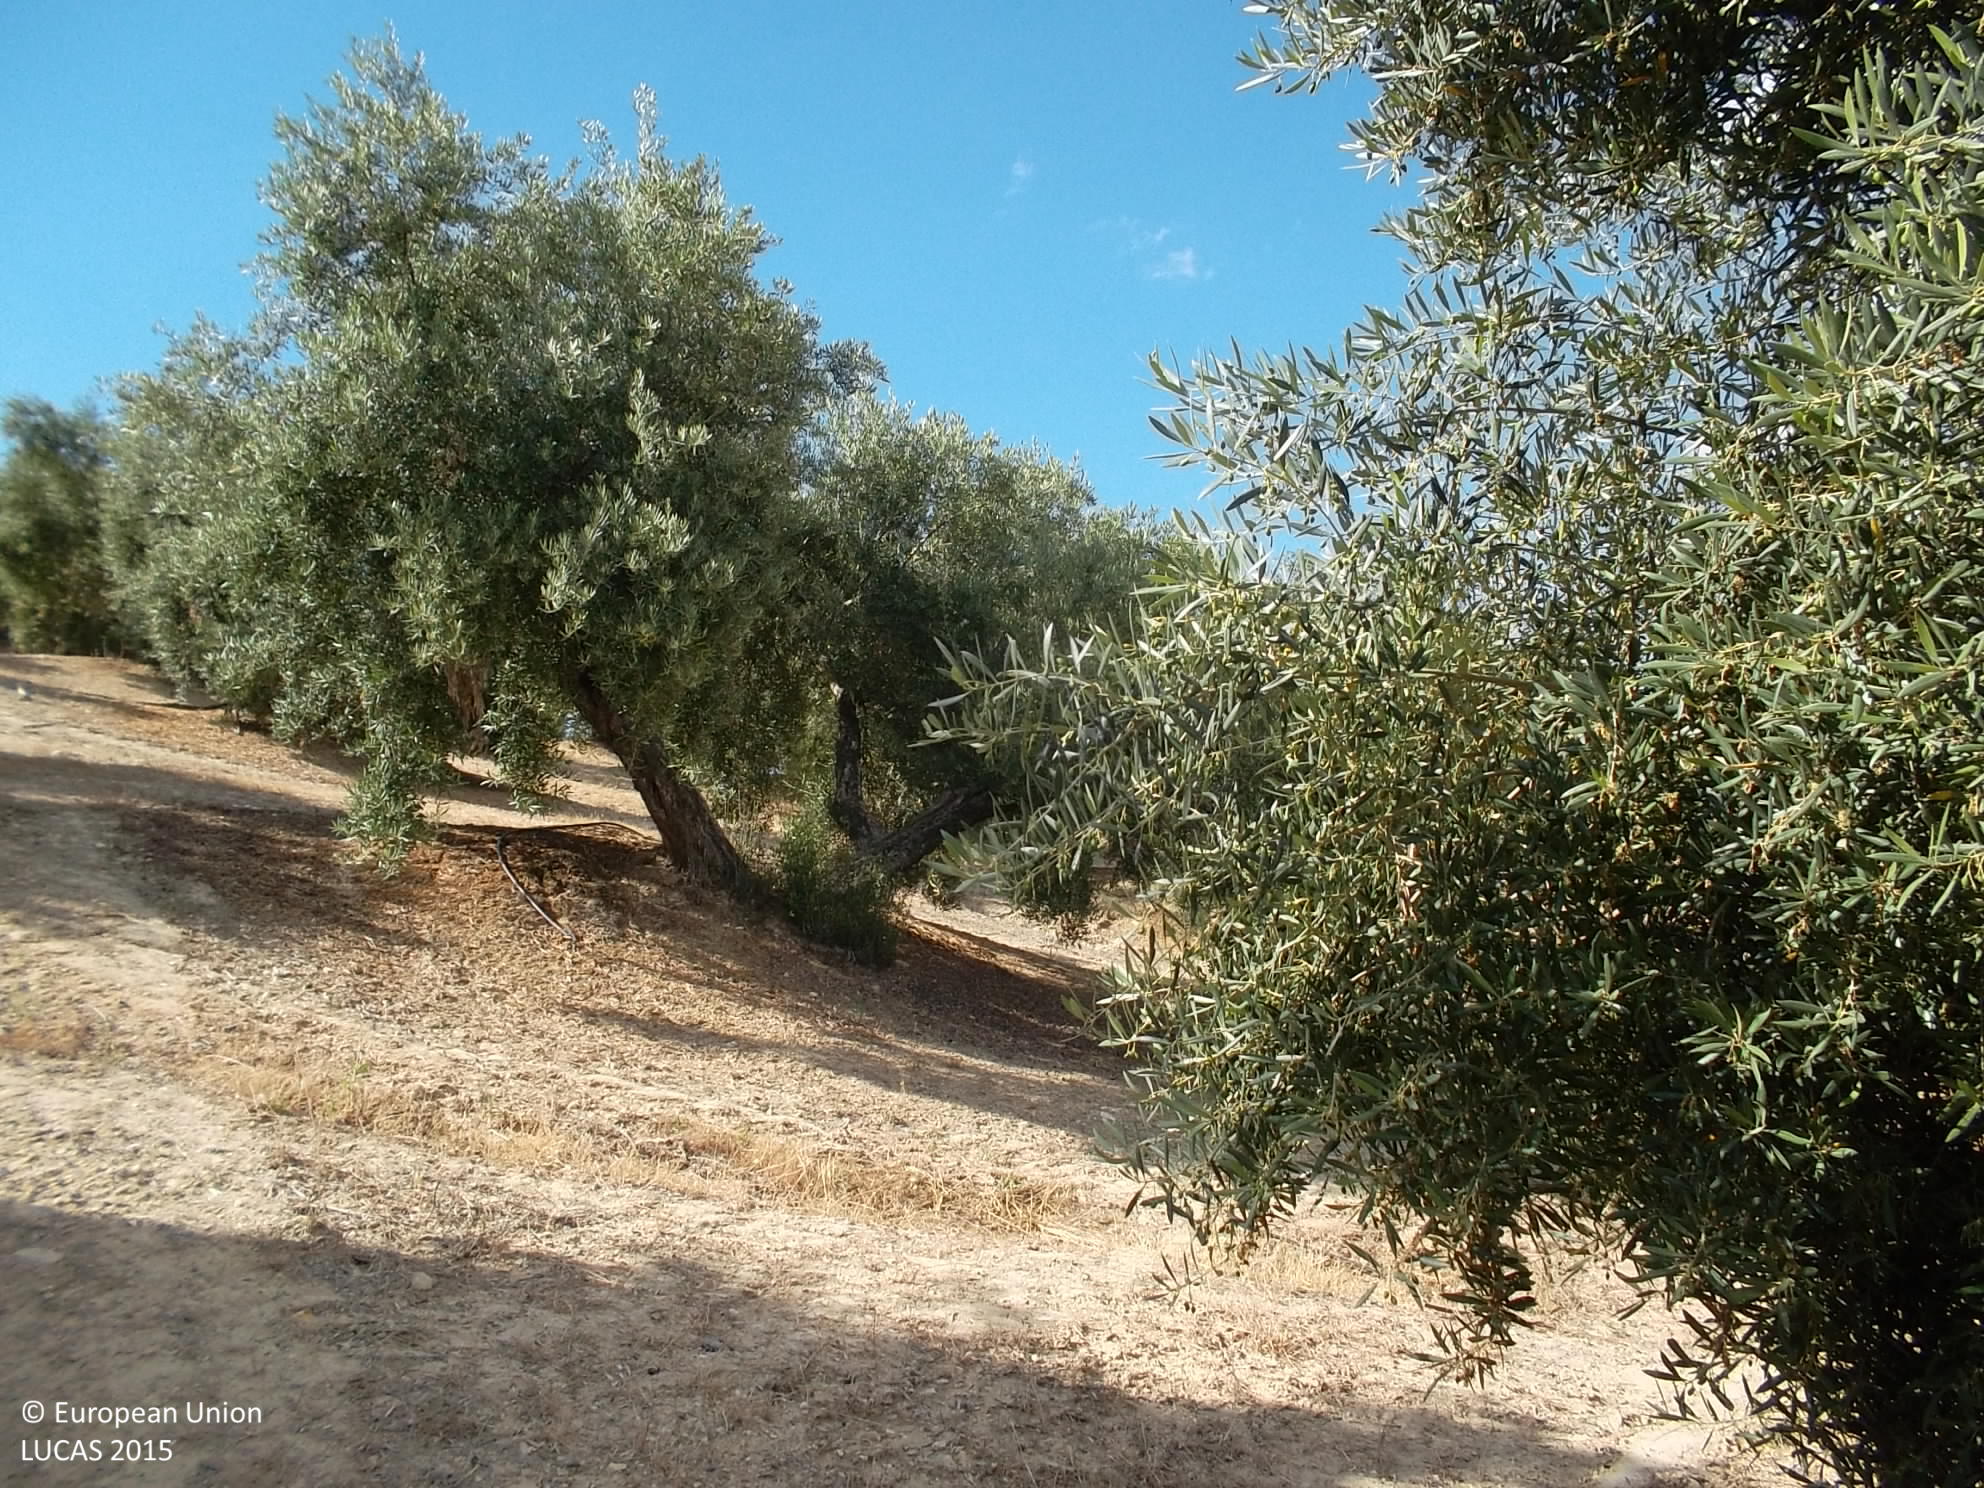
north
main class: Cropland
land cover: Olive groves
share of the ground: 50 - 75 %
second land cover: Other bare soil
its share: > 75 %
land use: Agriculture (excluding fallow land and kitchen gardens)
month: June
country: ES
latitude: 38.0045
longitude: -3.0138
